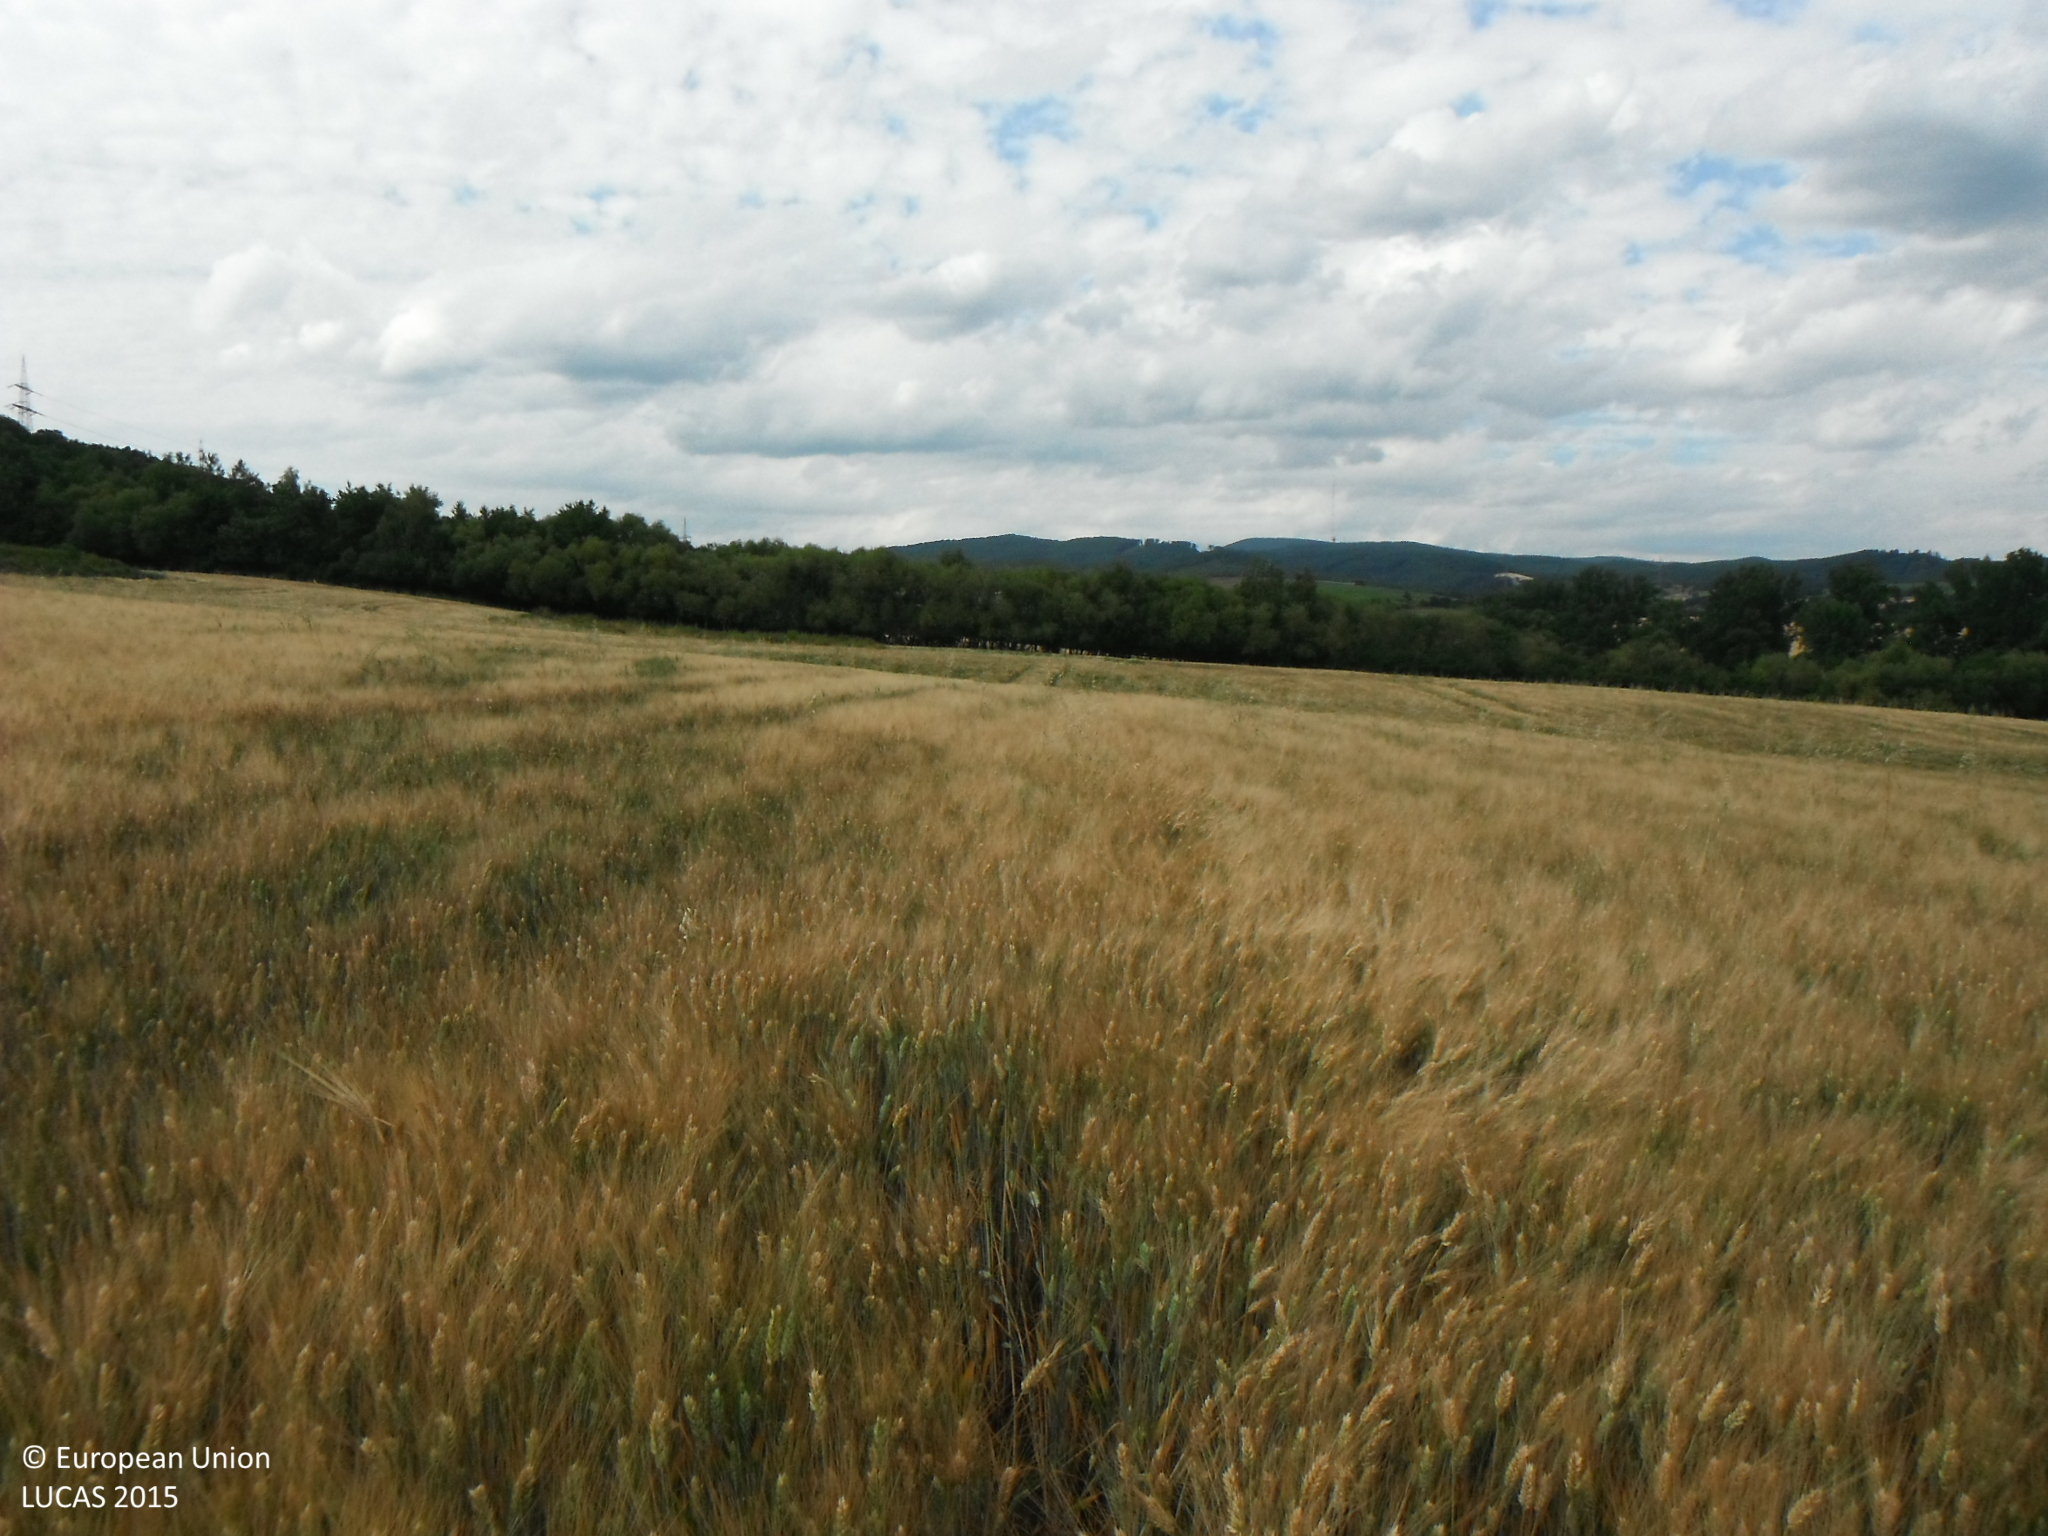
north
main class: Cropland
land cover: Durum wheat
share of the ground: > 75 %
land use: Agriculture (excluding fallow land and kitchen gardens)
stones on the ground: < 10 %
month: July
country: SK
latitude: 48.8625
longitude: 21.4293
